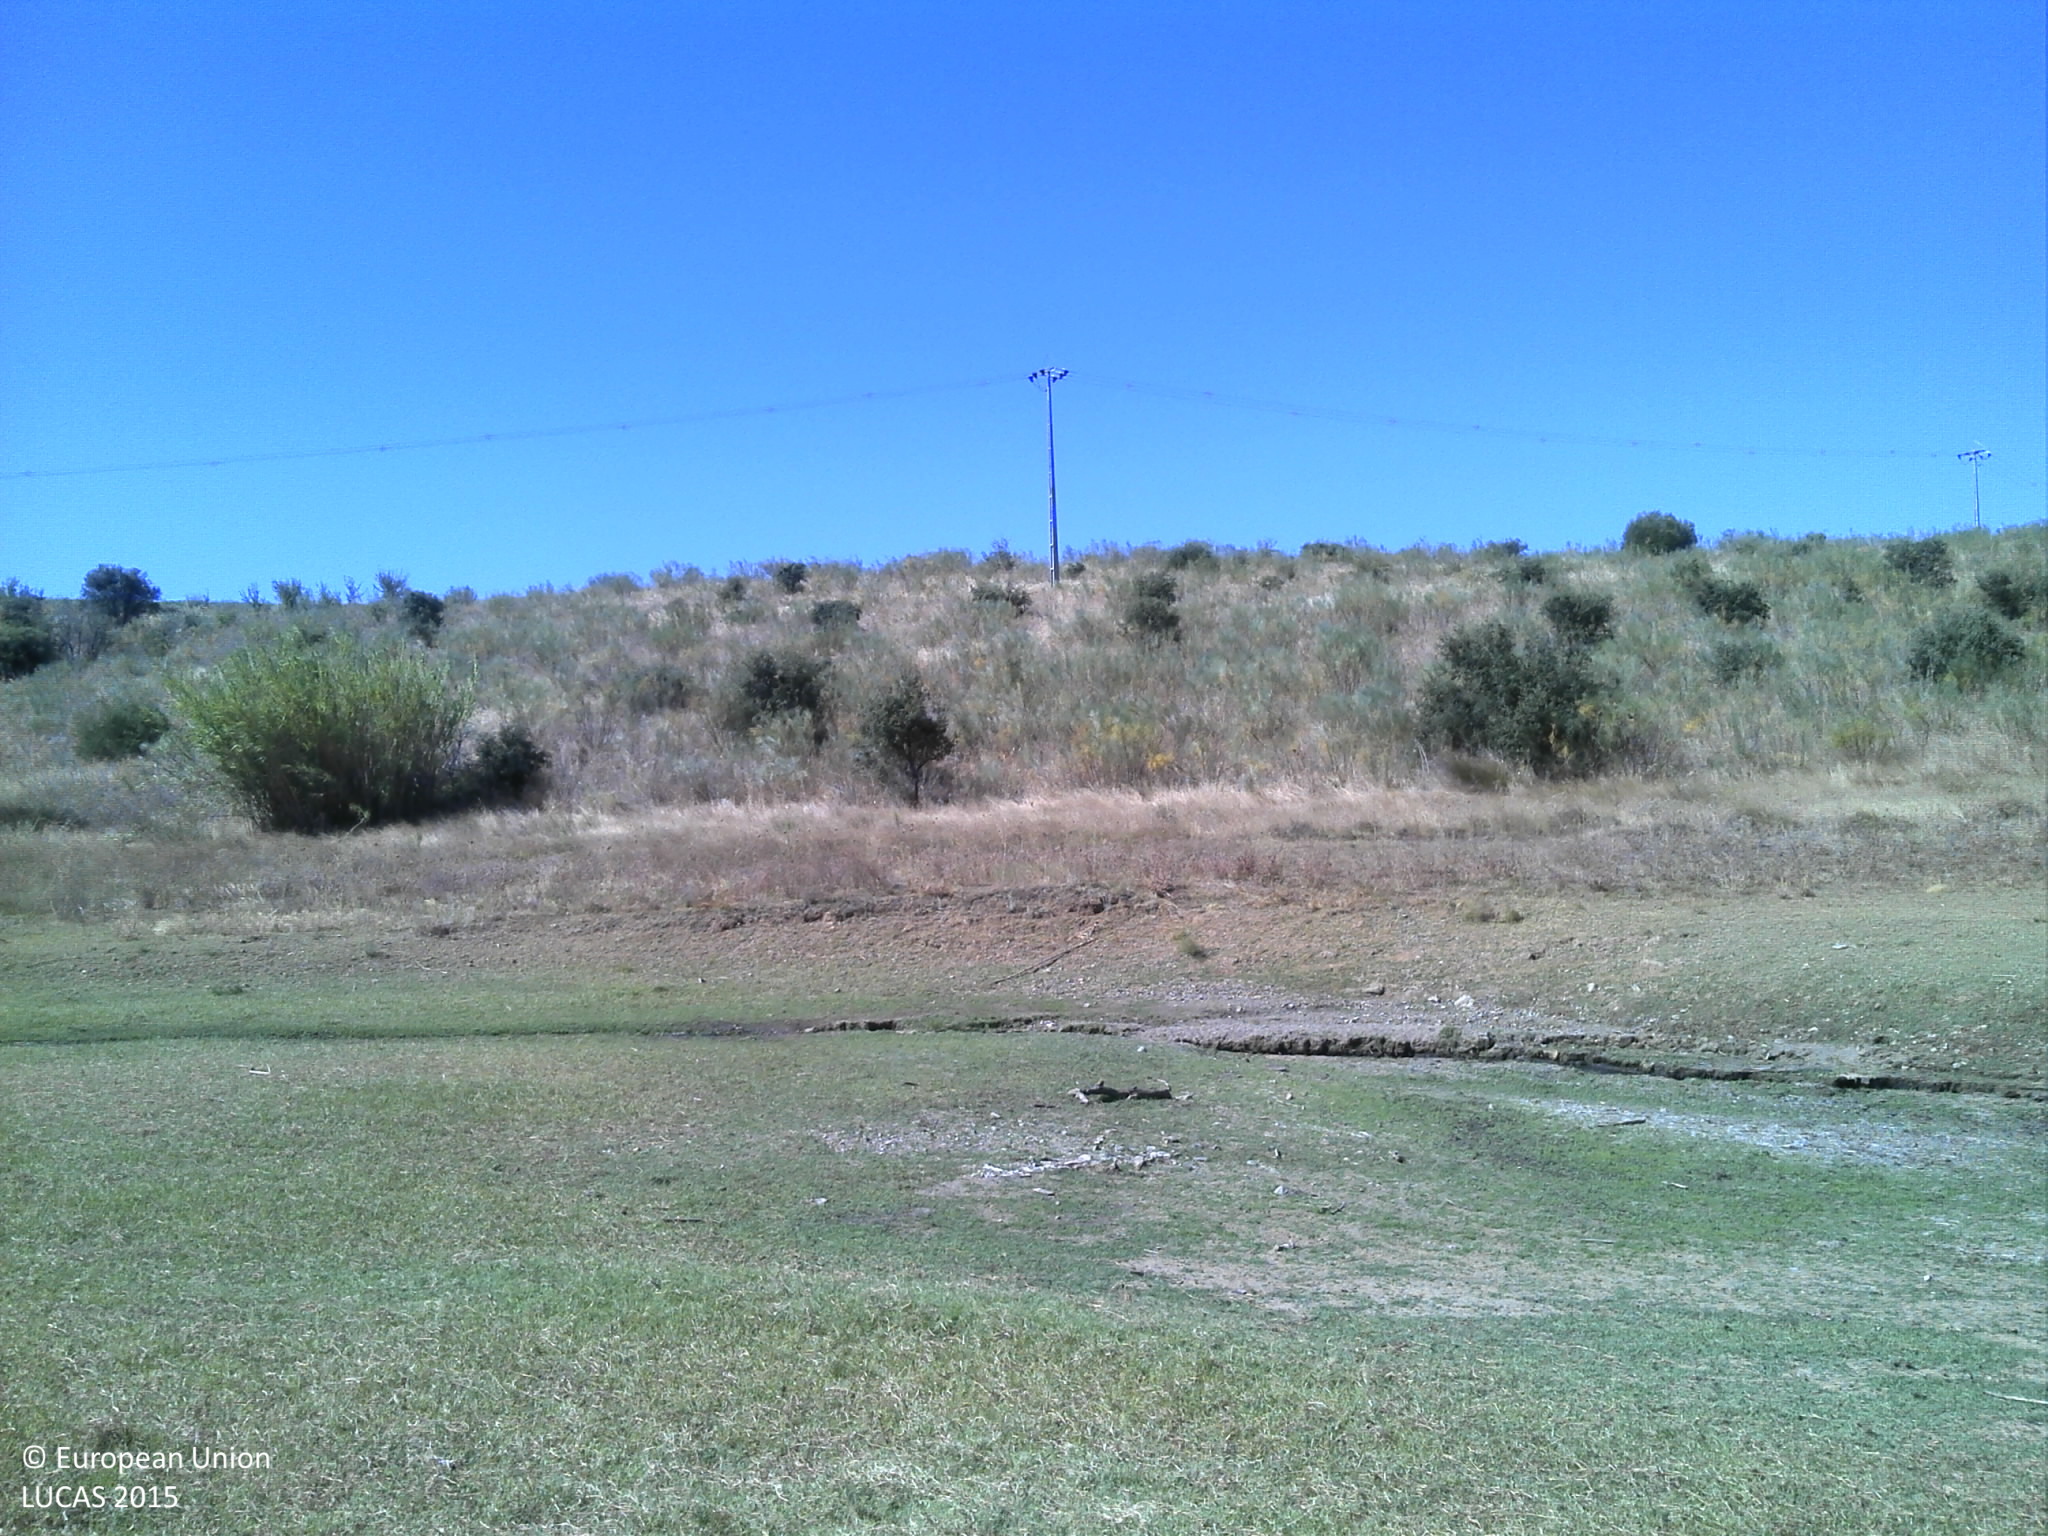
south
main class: Grassland
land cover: Grassland without tree/shrub cover
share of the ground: 10 - 25 %
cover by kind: unconsolidated bare surface 85 %, herbaceous plants 15 %
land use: Agriculture (excluding fallow land and kitchen gardens)
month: July
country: PT
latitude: 39.0237
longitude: -7.1363
